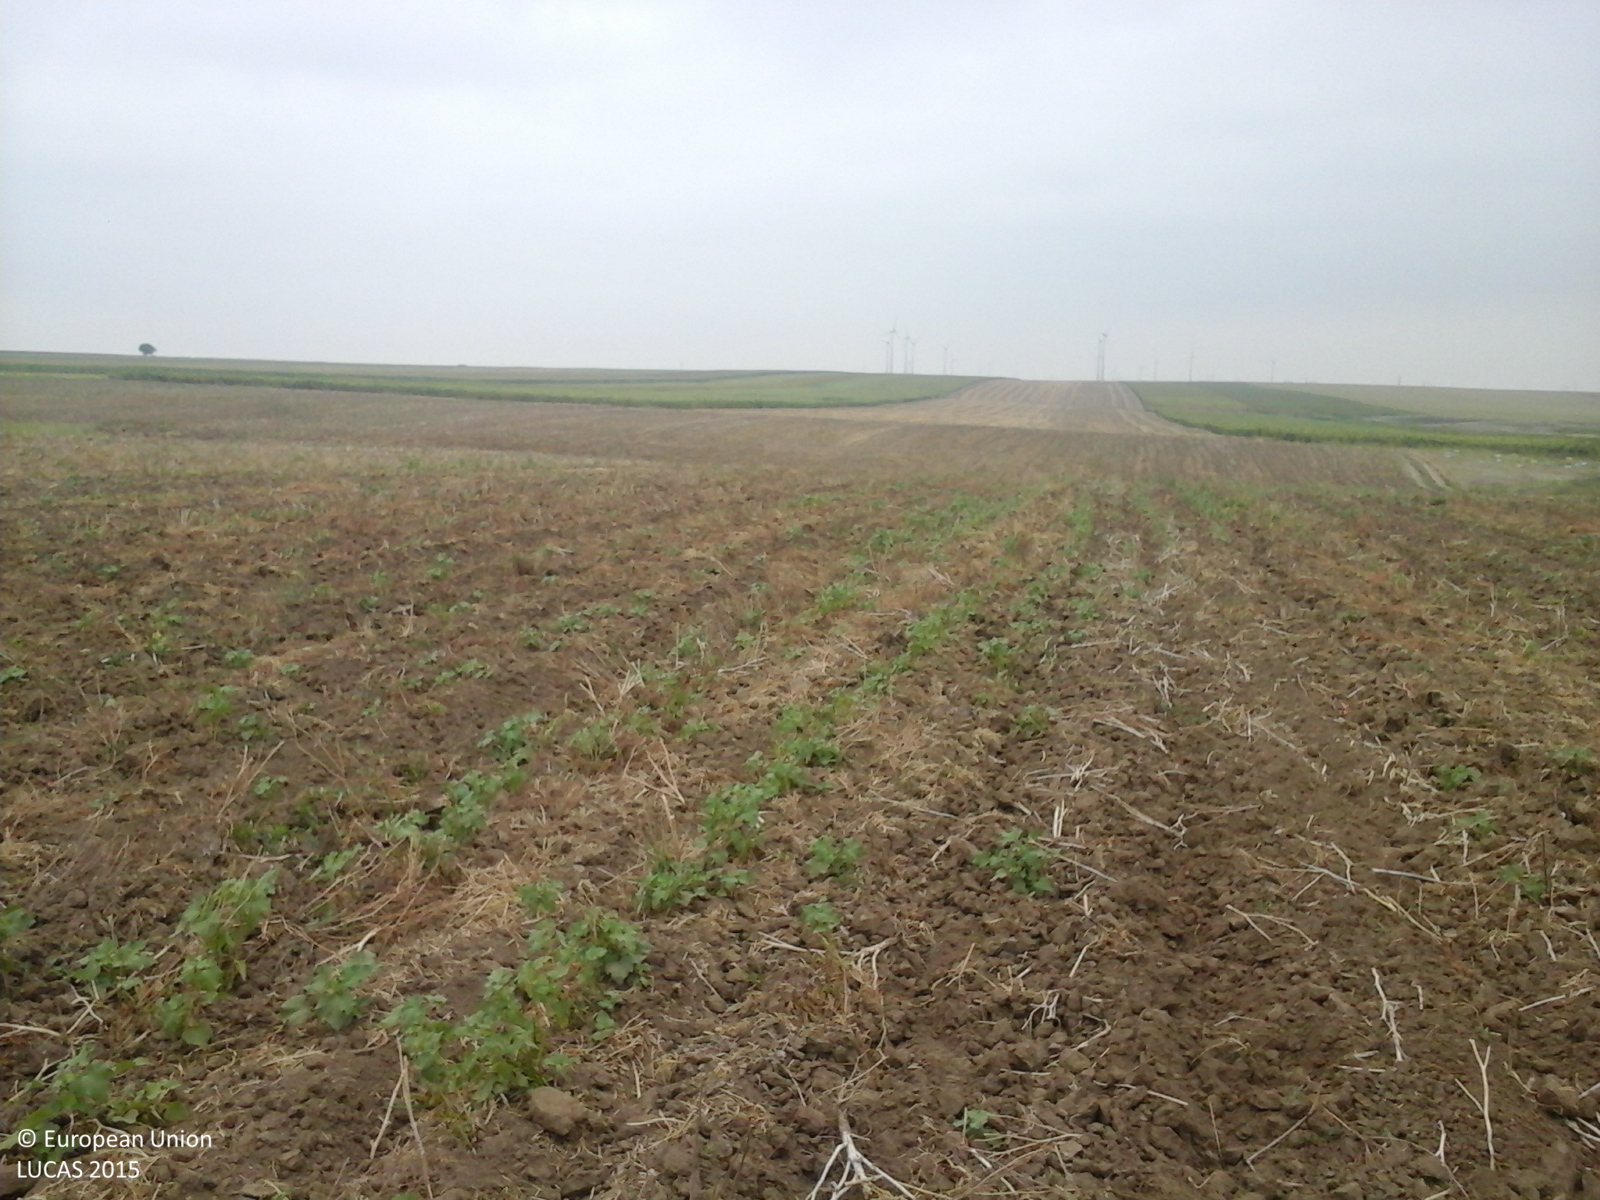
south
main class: Cropland
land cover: Rape and turnip rape
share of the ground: 10 - 25 %
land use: Agriculture (excluding fallow land and kitchen gardens)
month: August
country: RO
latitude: 44.8467
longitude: 28.3020
